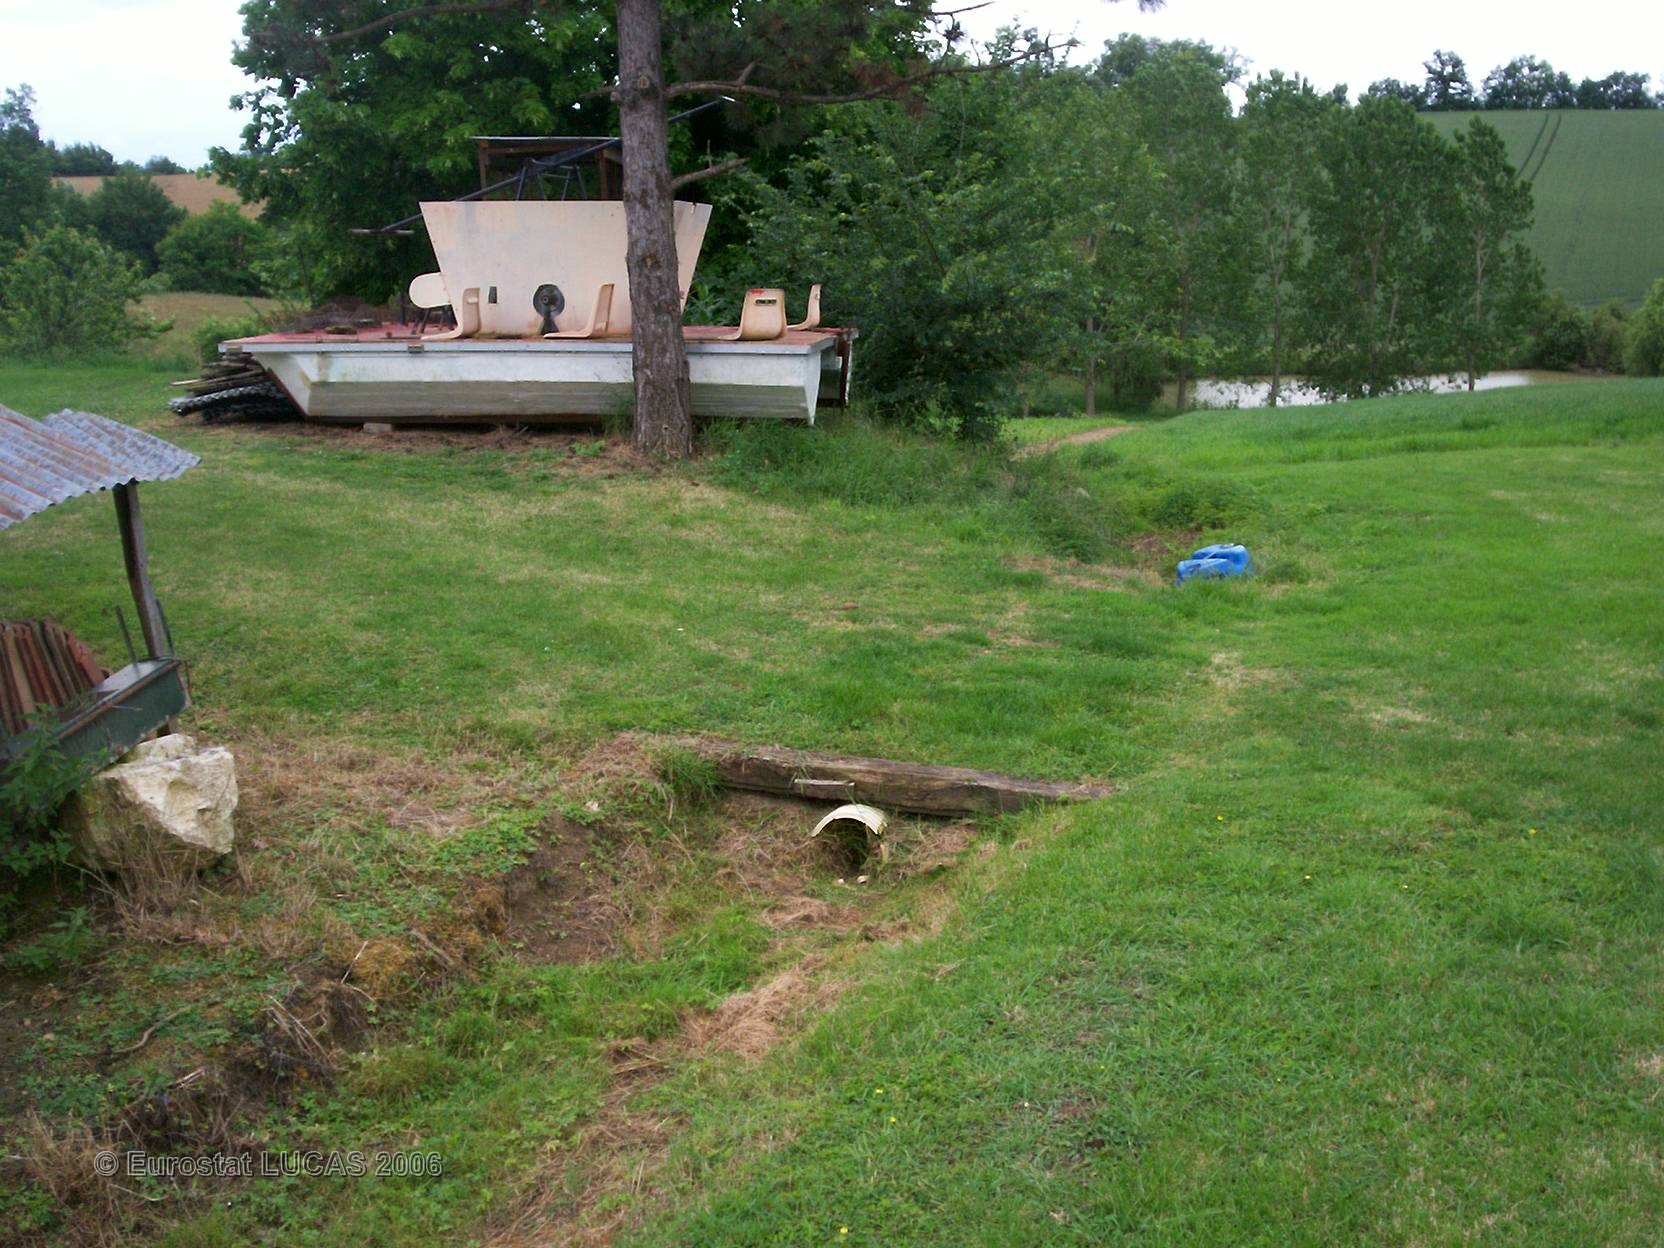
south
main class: Grassland
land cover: Grassland without tree/shrub cover
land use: Residential
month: May
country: FR
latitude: 43.6292
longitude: 0.9648
